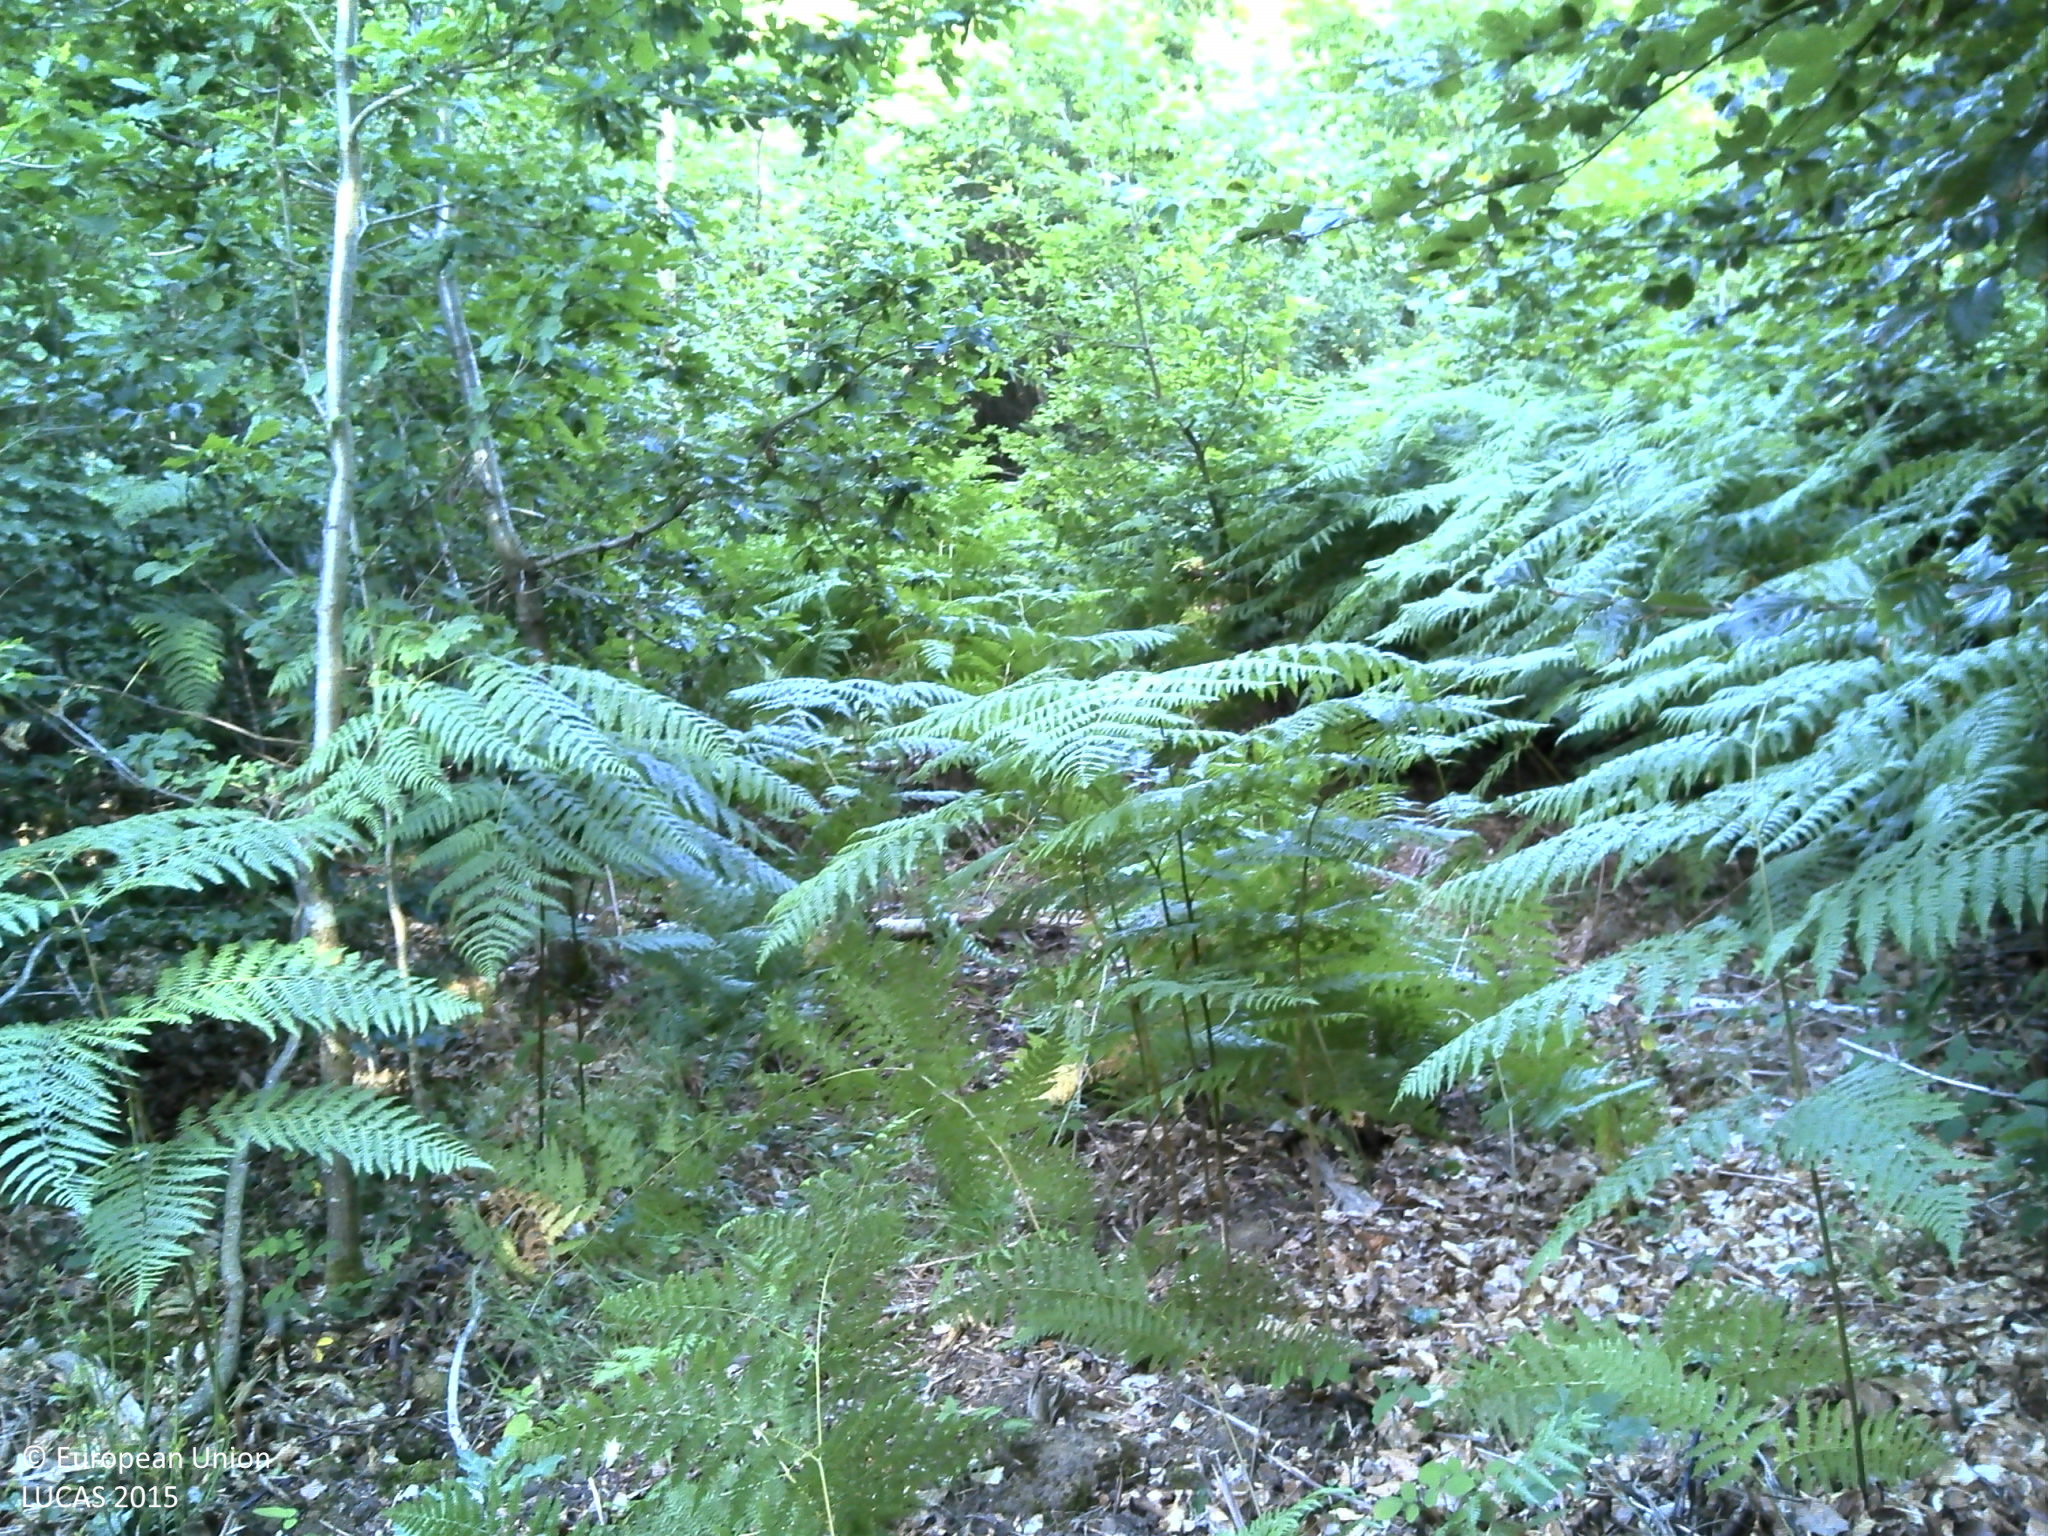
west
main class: Woodland
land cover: Broadleaved woodland
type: beech forest
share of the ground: > 75 %
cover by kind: broadleaved forest trees 90 %, herbaceous plants 5 %, unconsolidated bare surface 5 %
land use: Forestry
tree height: > 5 m
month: July
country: FR
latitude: 48.0294
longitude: 6.1251
